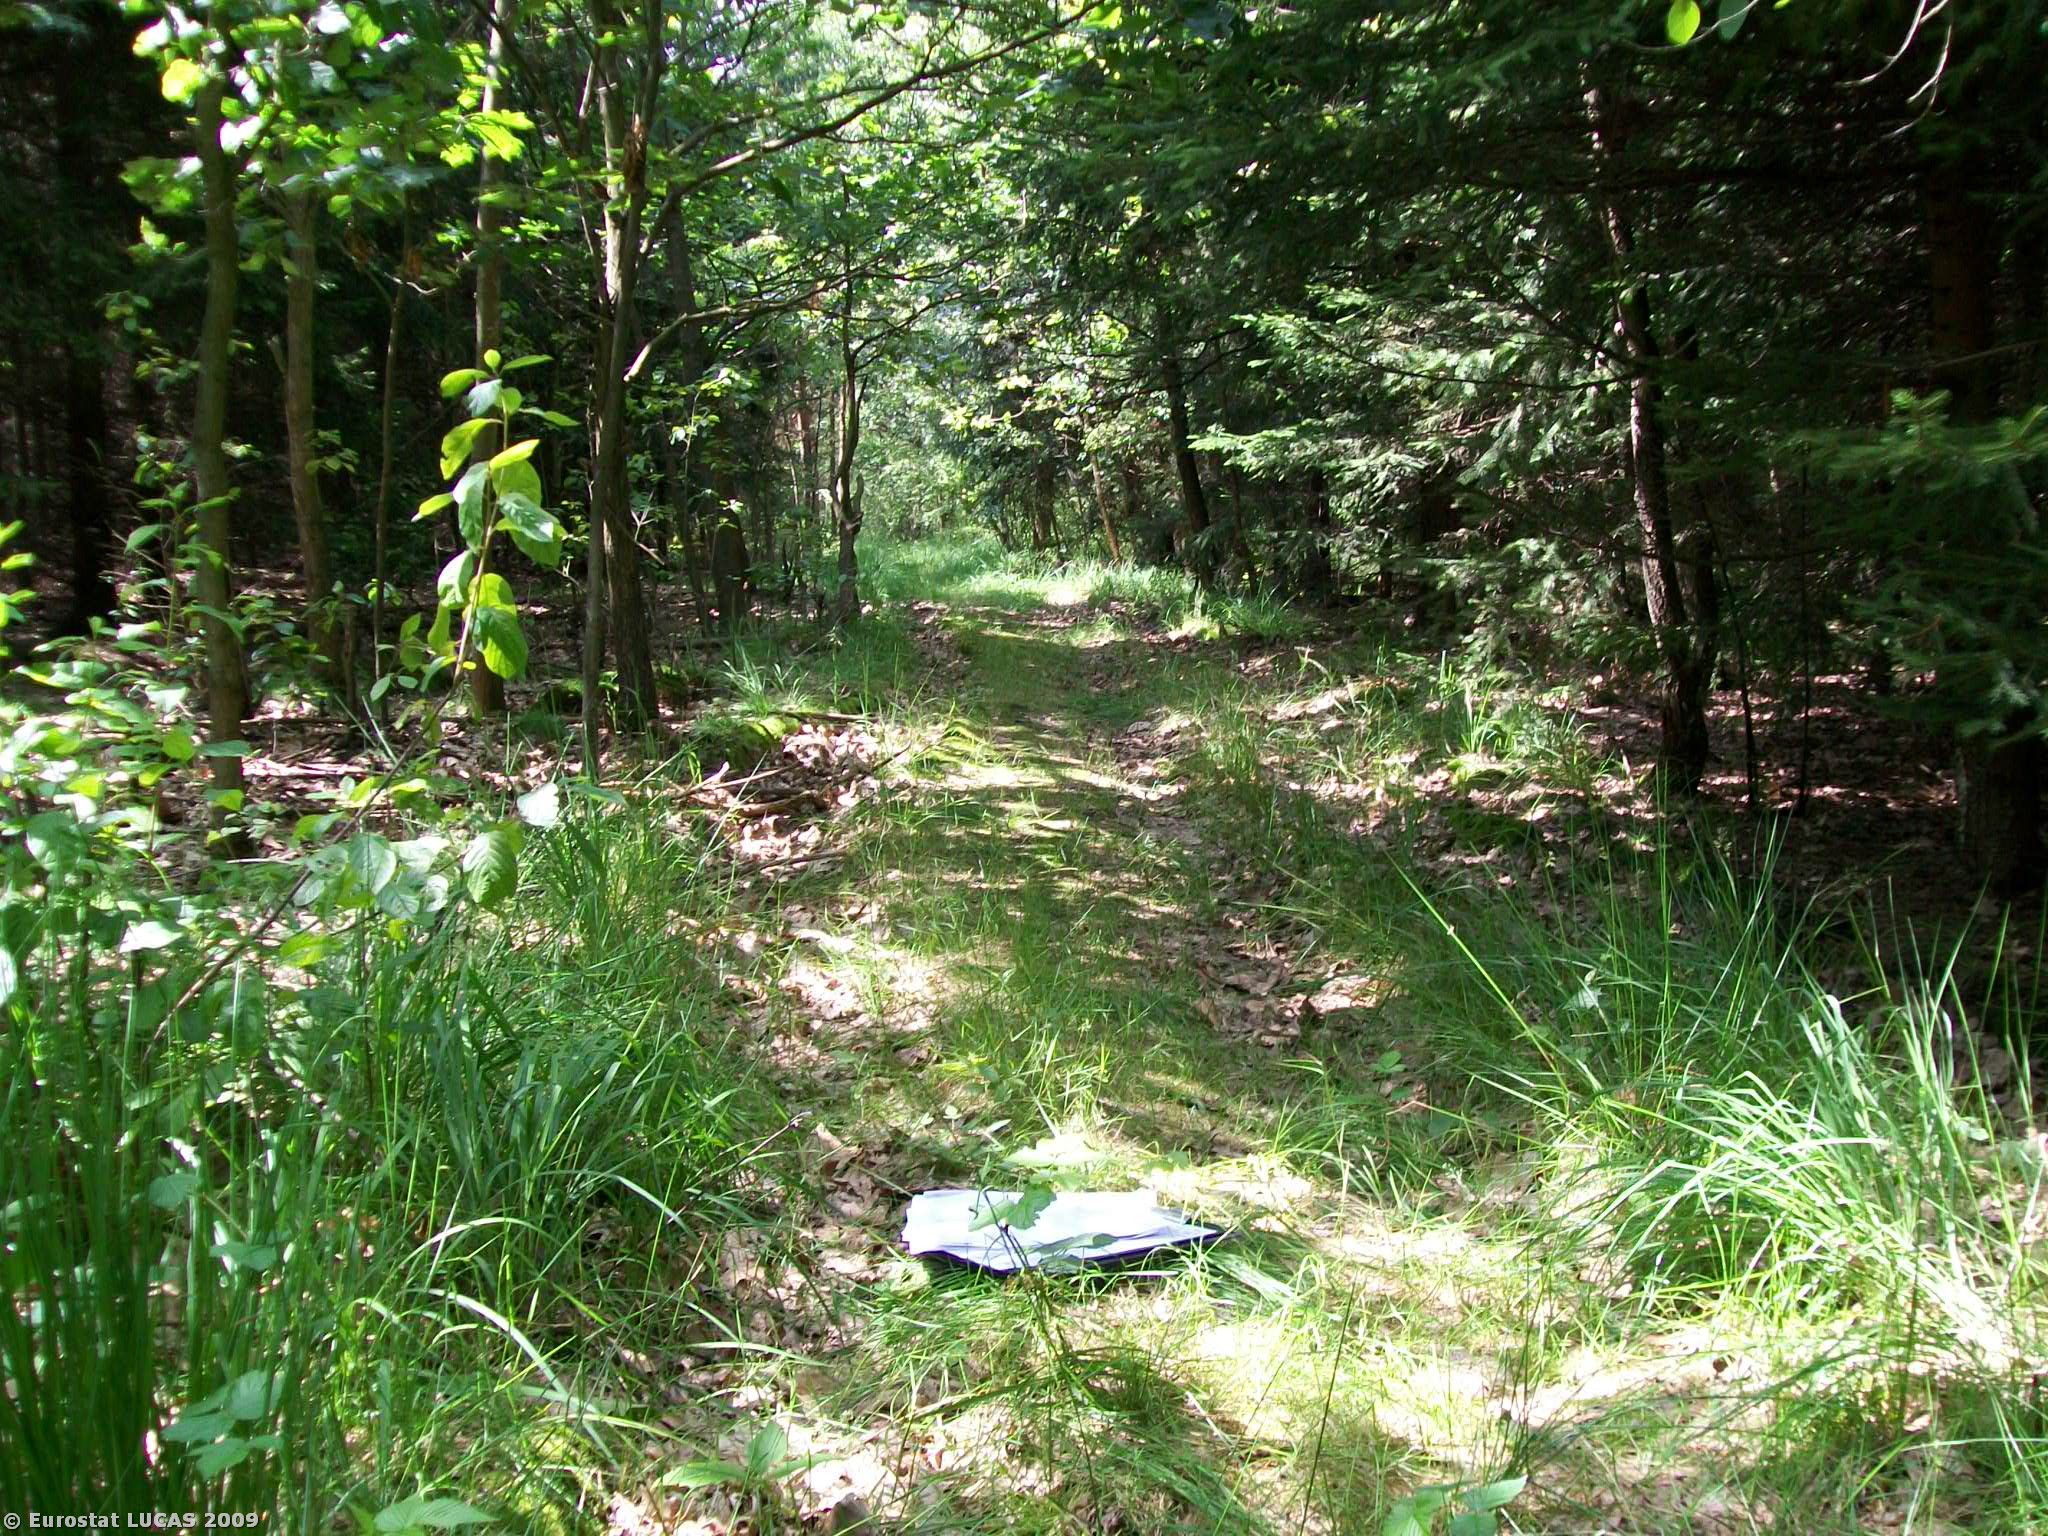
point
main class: Woodland
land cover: Coniferous woodland
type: hemiboreal forest and nemoral coniferous forest and mixed broadleaved-coniferous forest
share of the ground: > 75 %
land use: Unused
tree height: > 5 m
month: July
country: PL
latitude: 51.1736
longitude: 16.7745
